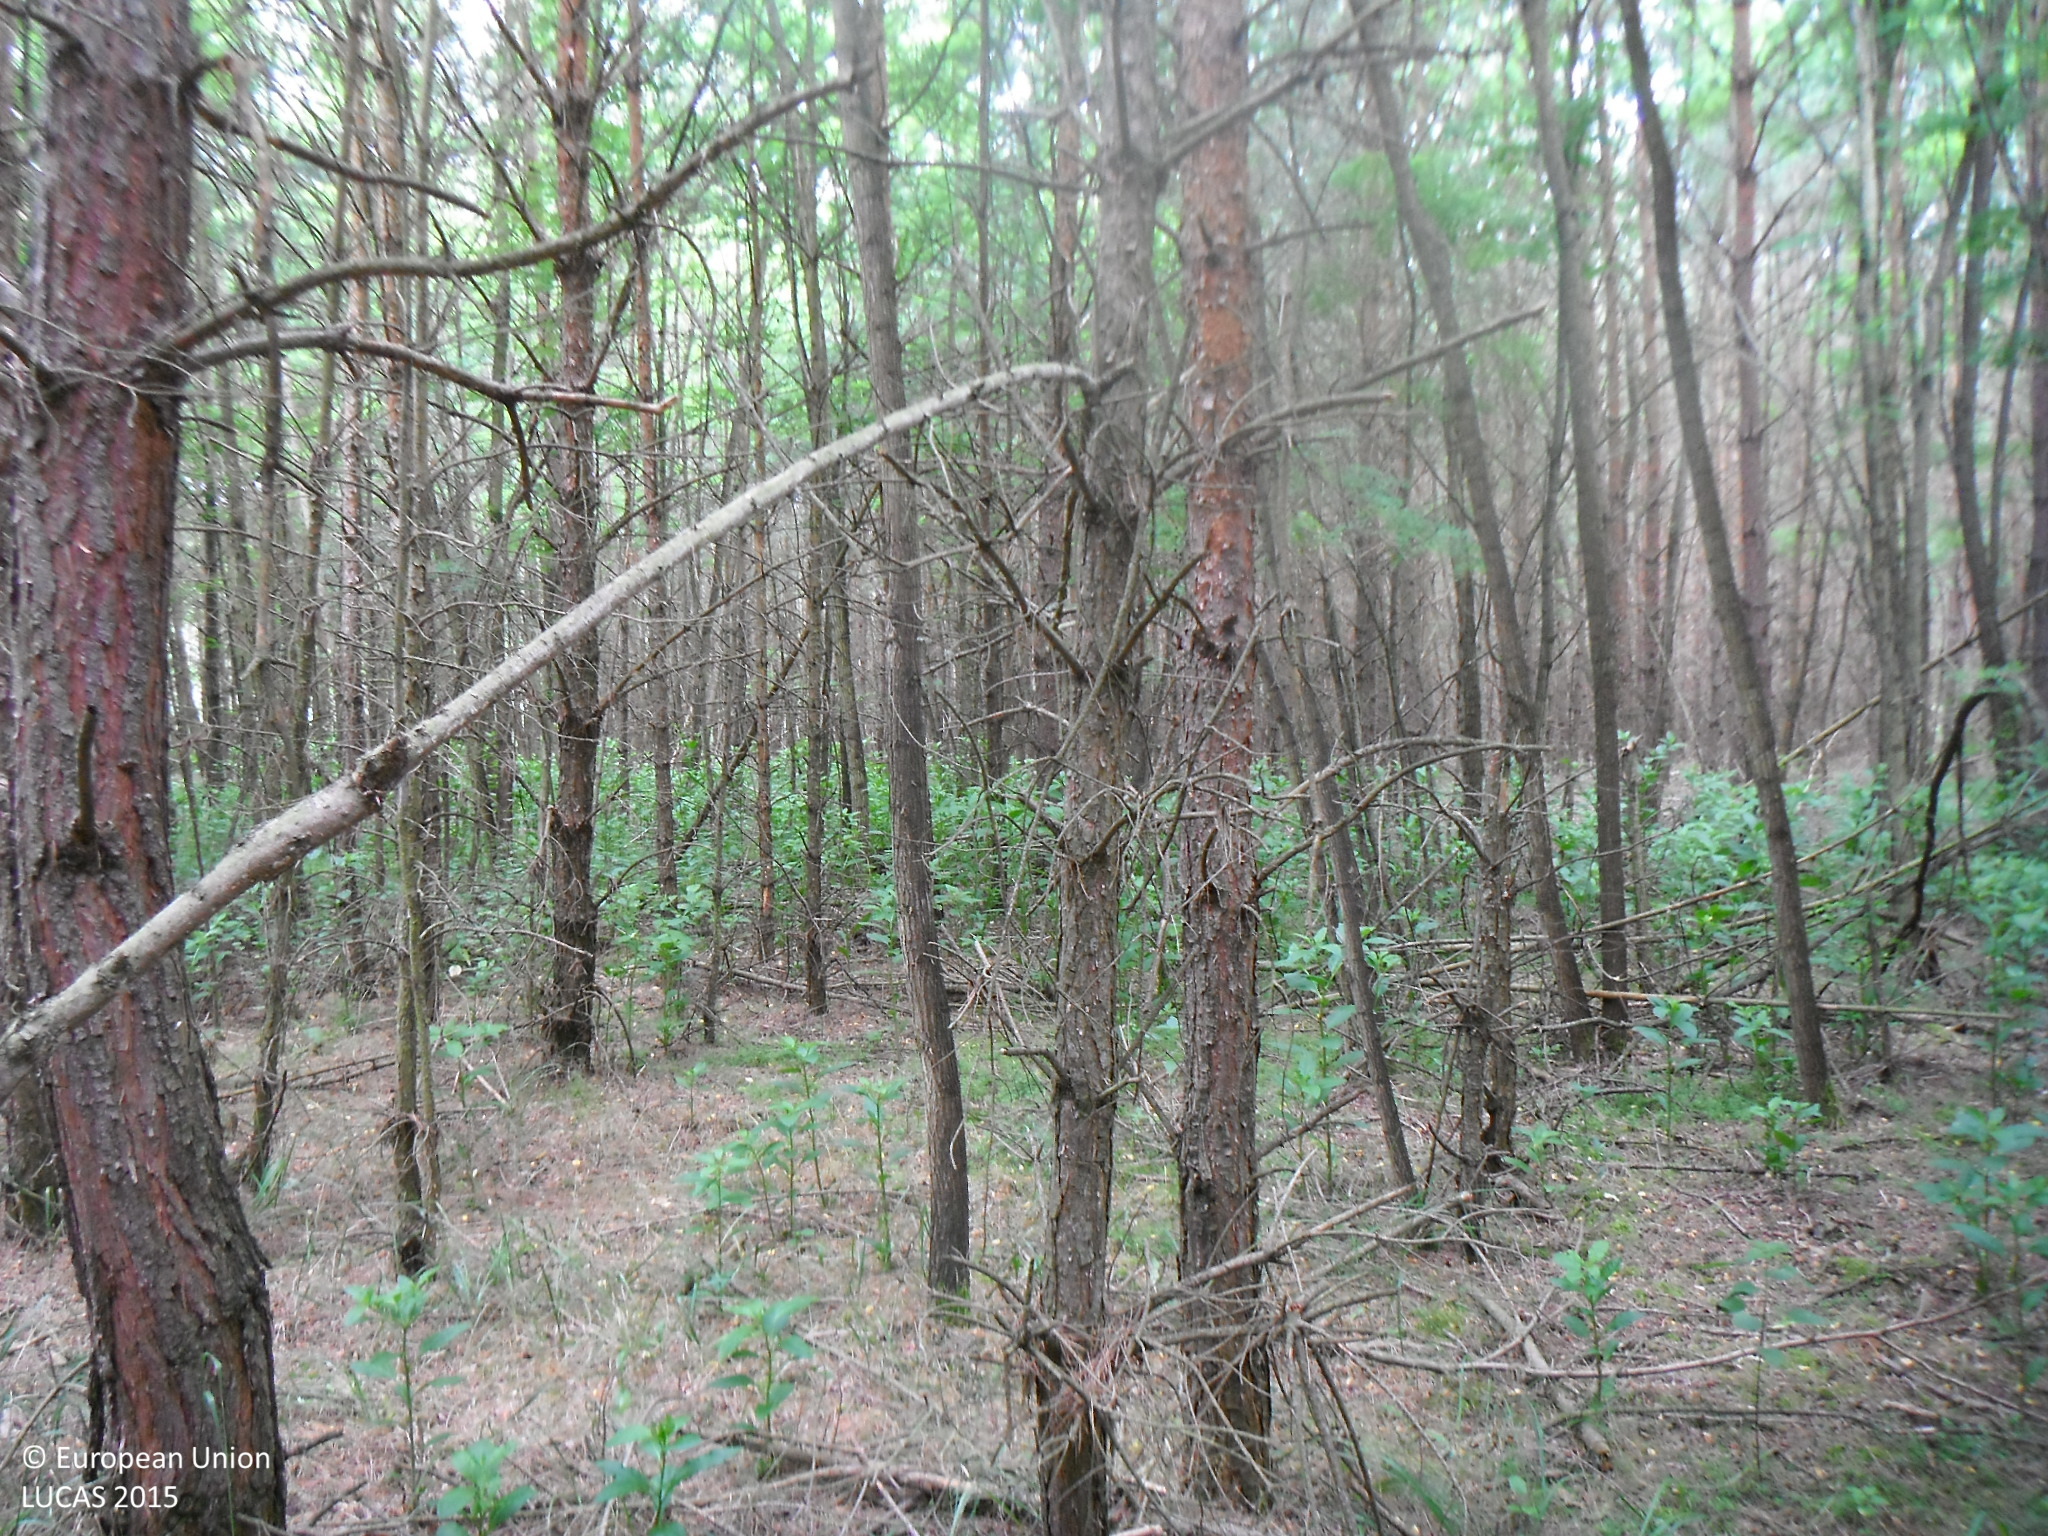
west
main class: Woodland
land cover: Pine dominated mixed woodland
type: hemiboreal forest and nemoral coniferous forest and mixed broadleaved-coniferous forest
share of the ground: > 75 %
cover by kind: coniferous forest trees 50 %, broadleaved forest trees 45 %, herbaceous plants 5 %
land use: Forestry
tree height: > 5 m
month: June
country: SK
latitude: 48.6229
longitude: 17.1587
